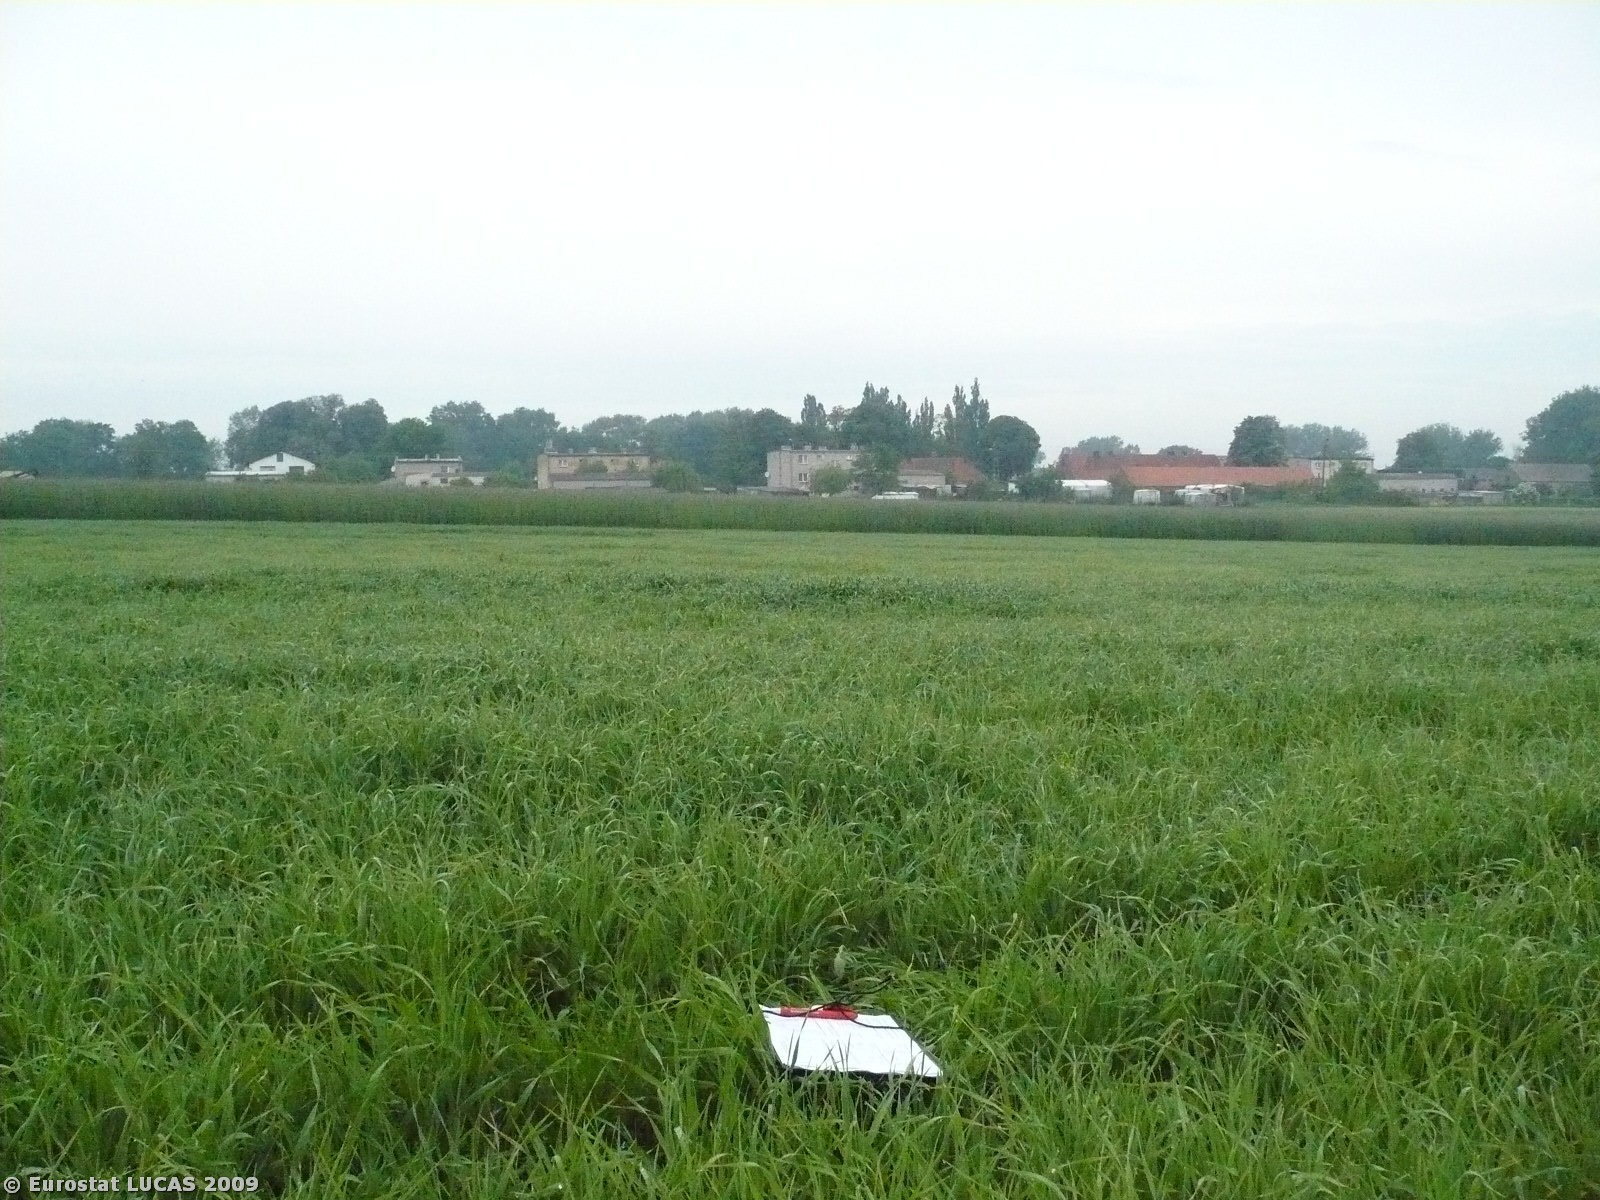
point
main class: Grassland
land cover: Grassland without tree/shrub cover
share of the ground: > 75 %
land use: Agriculture (excluding fallow land and kitchen gardens)
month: May
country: PL
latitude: 52.1915
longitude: 16.3117
